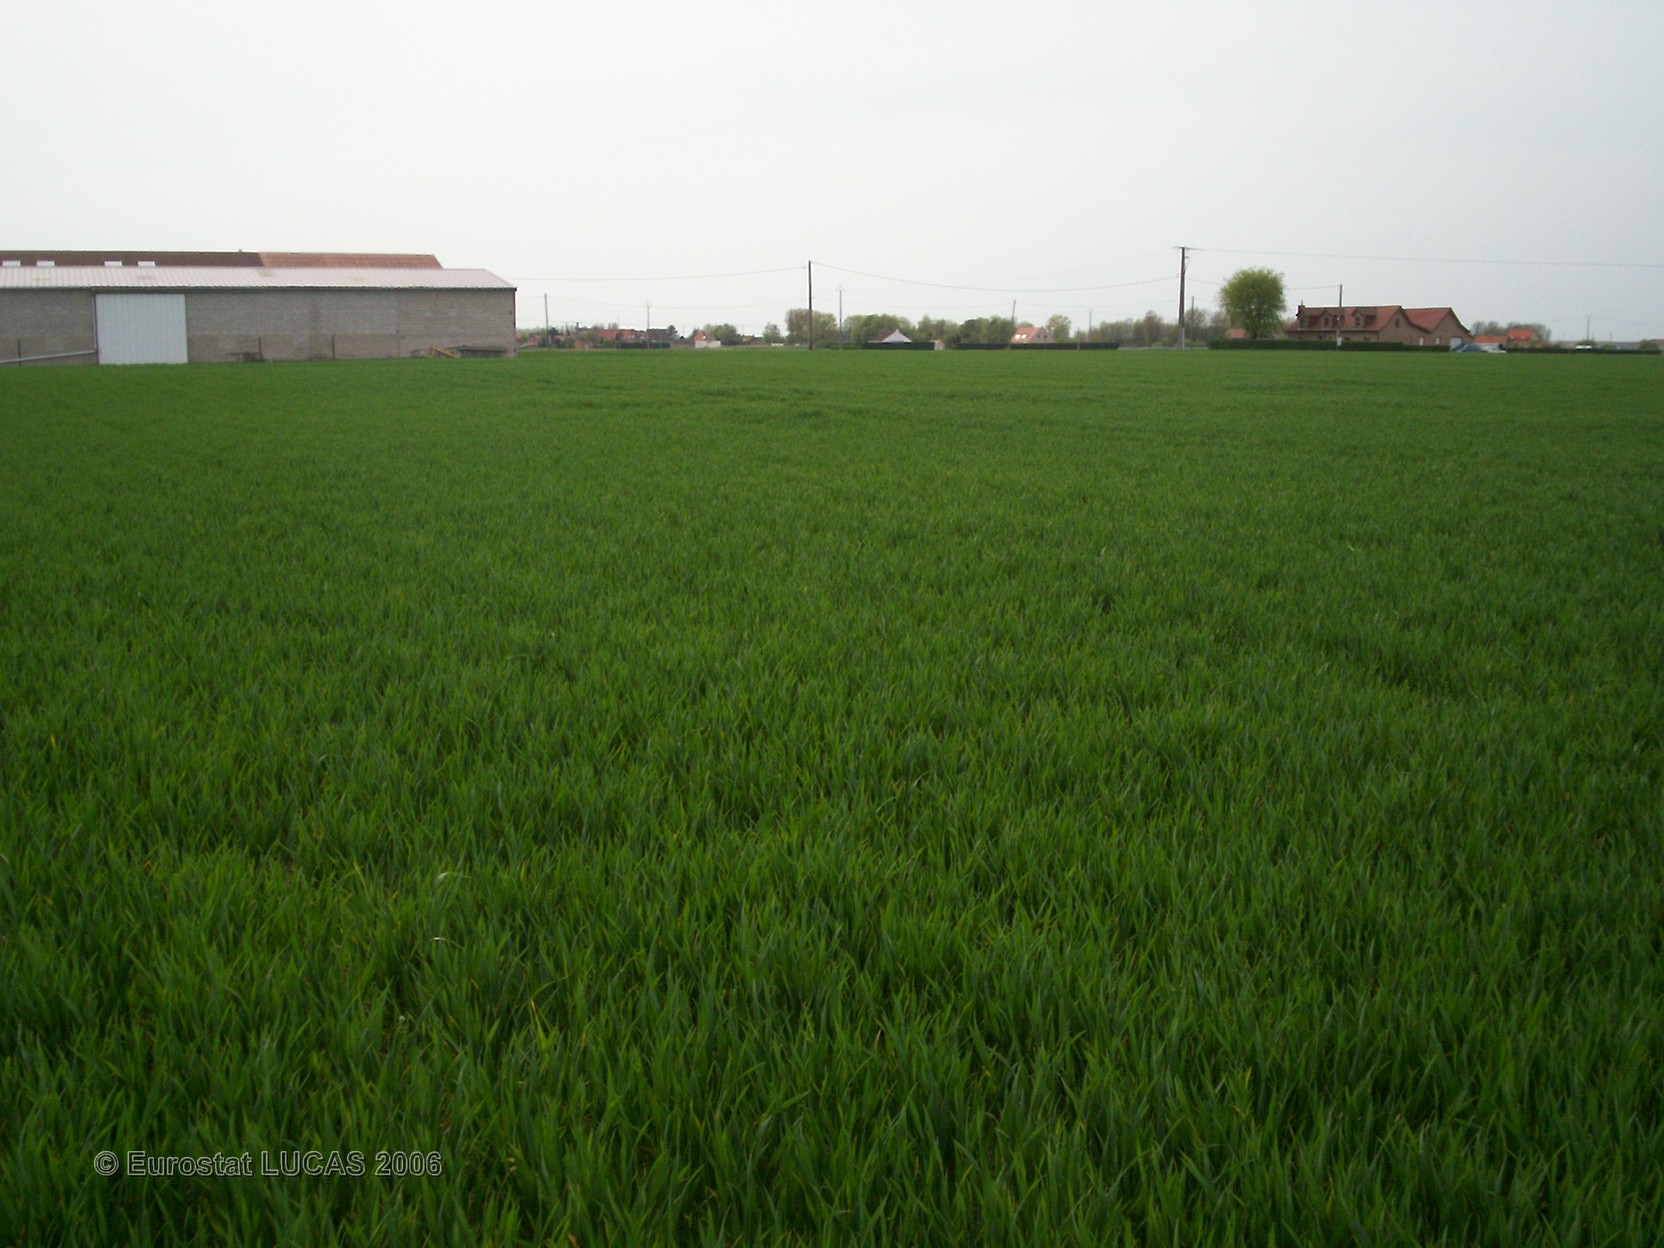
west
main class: Cropland
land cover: Common wheat
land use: Agriculture (excluding fallow land and kitchen gardens)
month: May
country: FR
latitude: 50.9832
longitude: 2.4802
